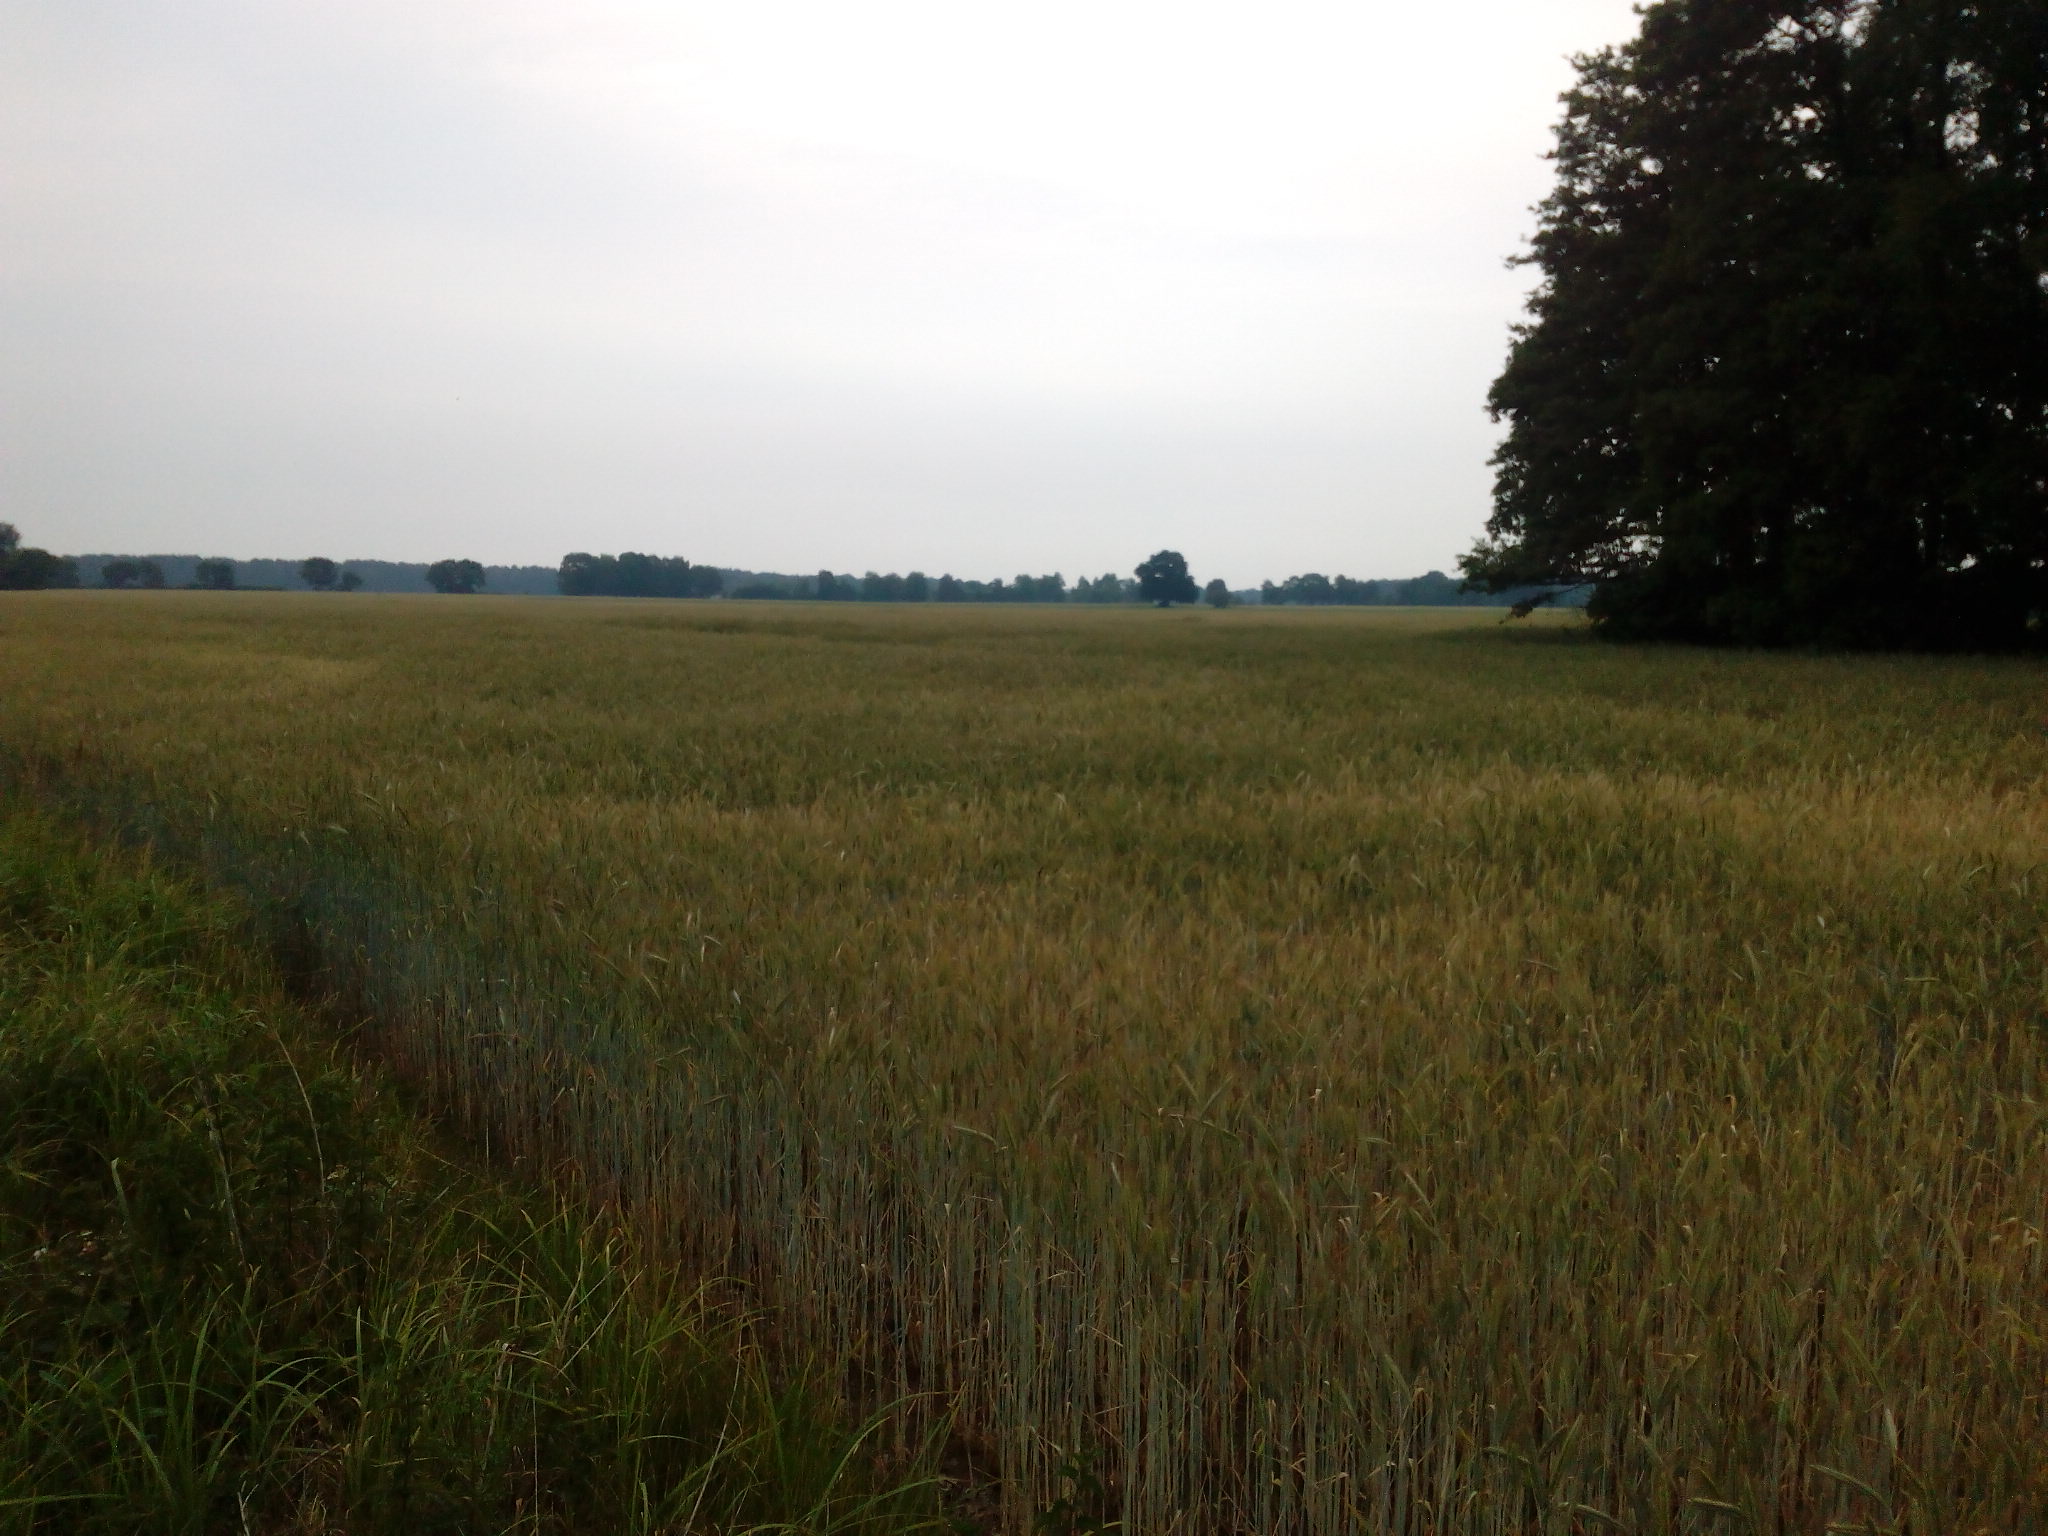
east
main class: Grassland
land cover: Grassland without tree/shrub cover
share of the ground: > 75 %
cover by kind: herbaceous plants 100 %
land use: Agriculture (excluding fallow land and kitchen gardens)
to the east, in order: Grassland without tree/shrub cover; Fences; Grass margins; Ditches and canals; Grassland without tree/shrub cover; Rye
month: June
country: DE
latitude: 52.7722
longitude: 9.6000
